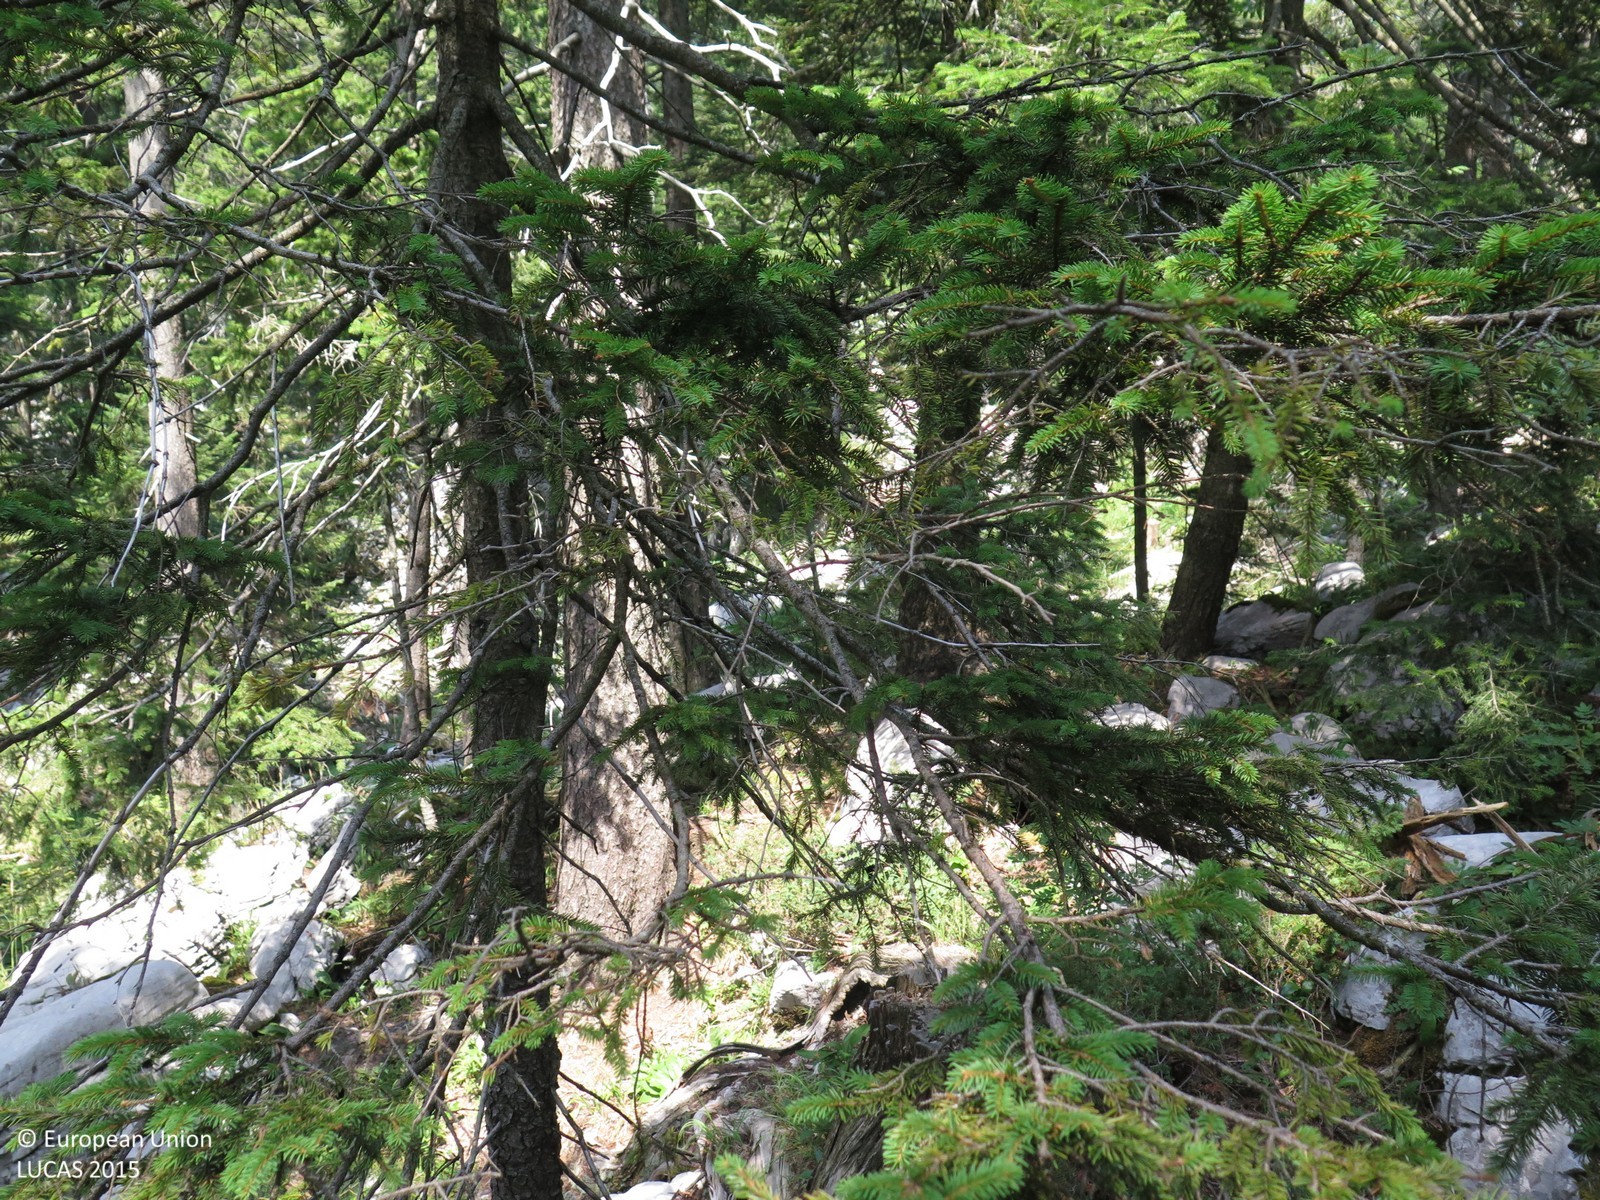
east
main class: Woodland
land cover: Other mixed woodland
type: coniferous forest of the mediterranean region
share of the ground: > 75 %
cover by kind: coniferous forest trees 70 %, broadleaved forest trees 25 %, unconsolidated bare surface 5 %
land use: Forestry
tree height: > 5 m
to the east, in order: Other mixed woodland; Rocks and stones; Other mixed woodland; Rocks and stones
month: August
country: HR
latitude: 45.4960
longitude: 14.5638
